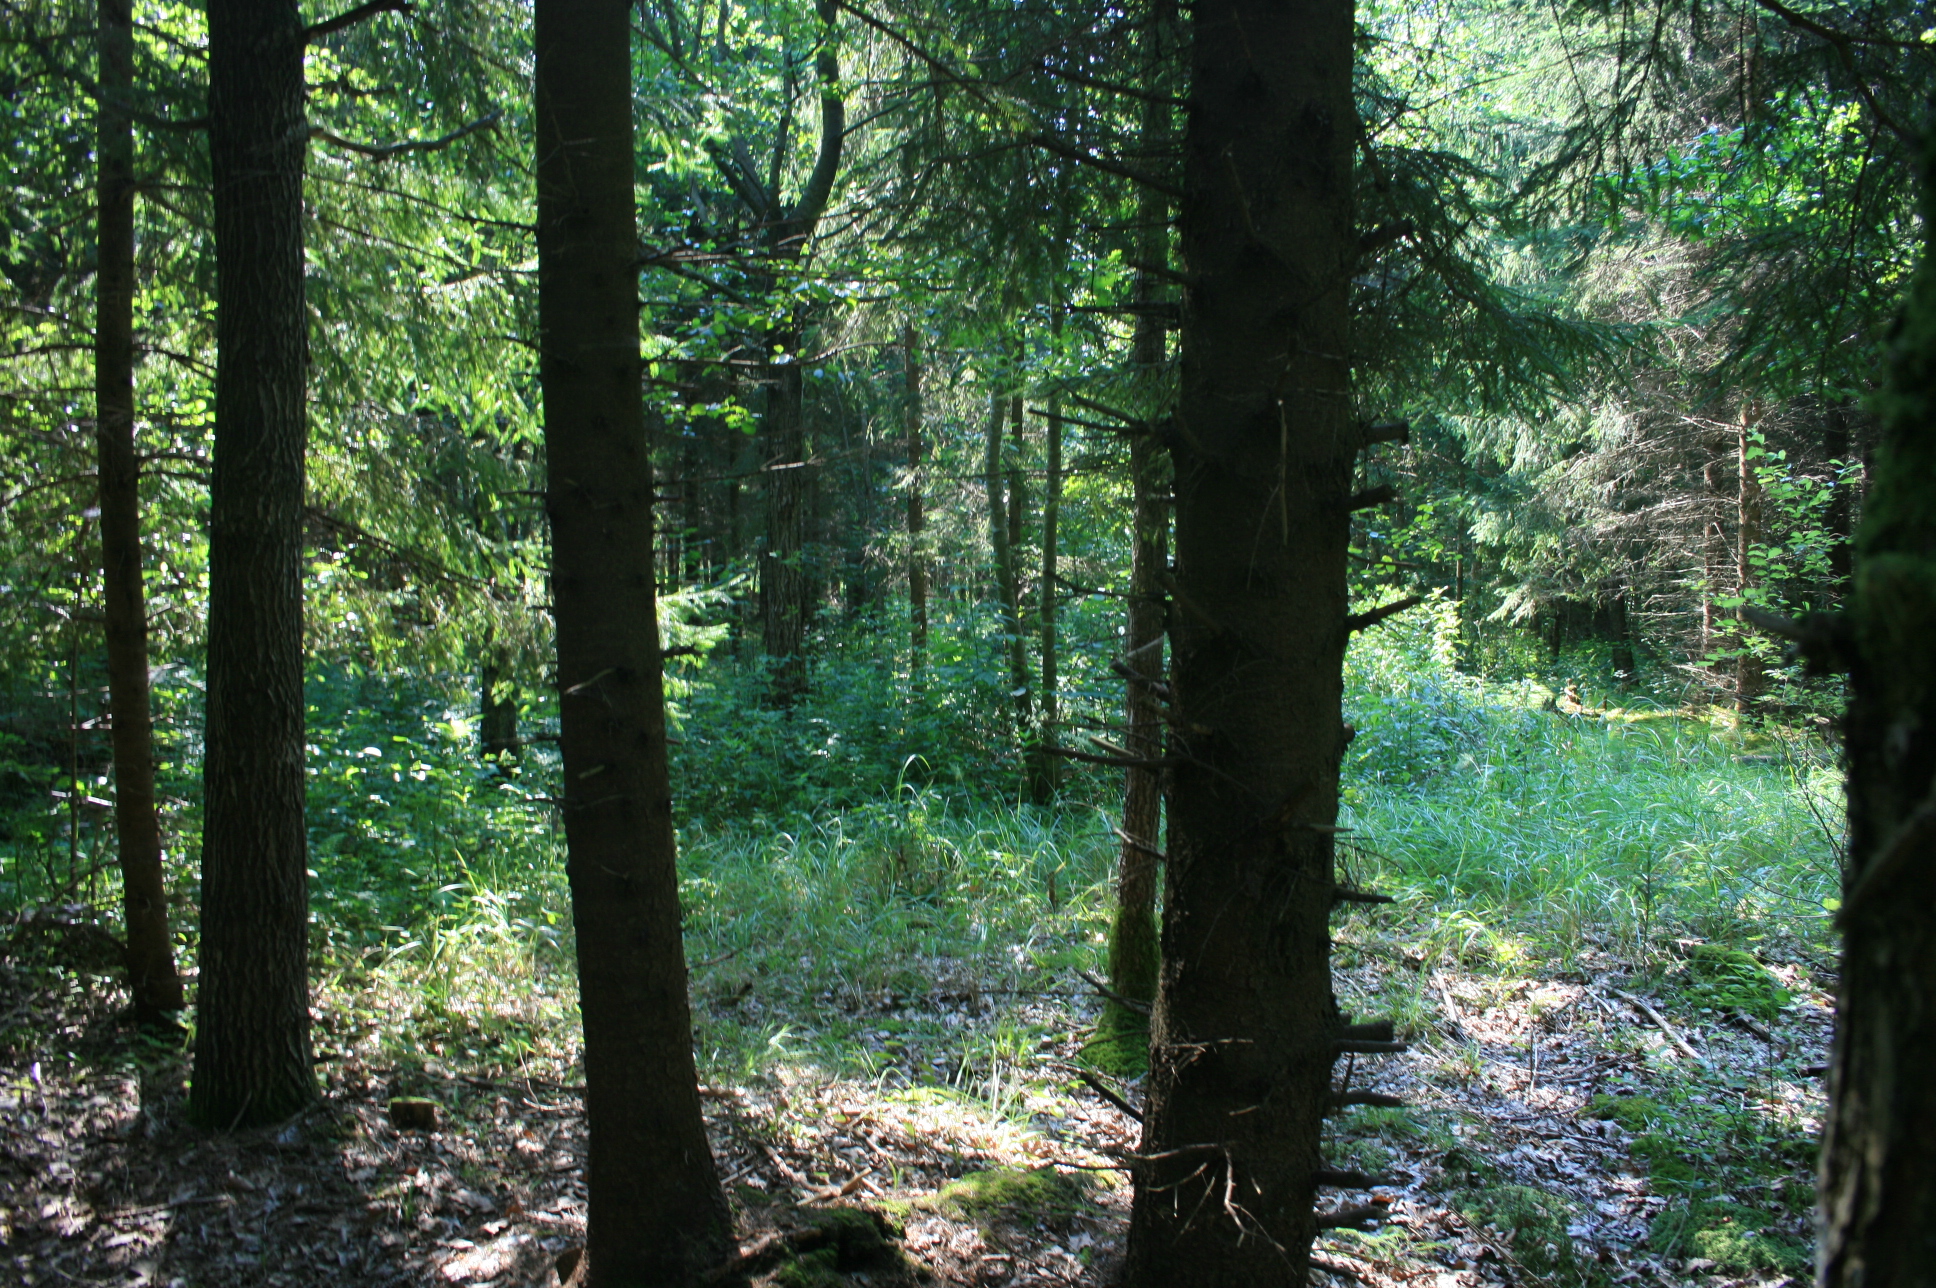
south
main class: Woodland
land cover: Spruce dominated mixed woodland
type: hemiboreal forest and nemoral coniferous forest and mixed broadleaved-coniferous forest
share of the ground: > 75 %
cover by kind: coniferous forest trees 60 %, broadleaved forest trees 25 %, shrubs 5 %, herbaceous plants 5 %, lichens and mosses 5 %
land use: Forestry
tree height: > 5 m
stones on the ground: < 10 %
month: August
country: LT
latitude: 55.5506
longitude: 21.7955
